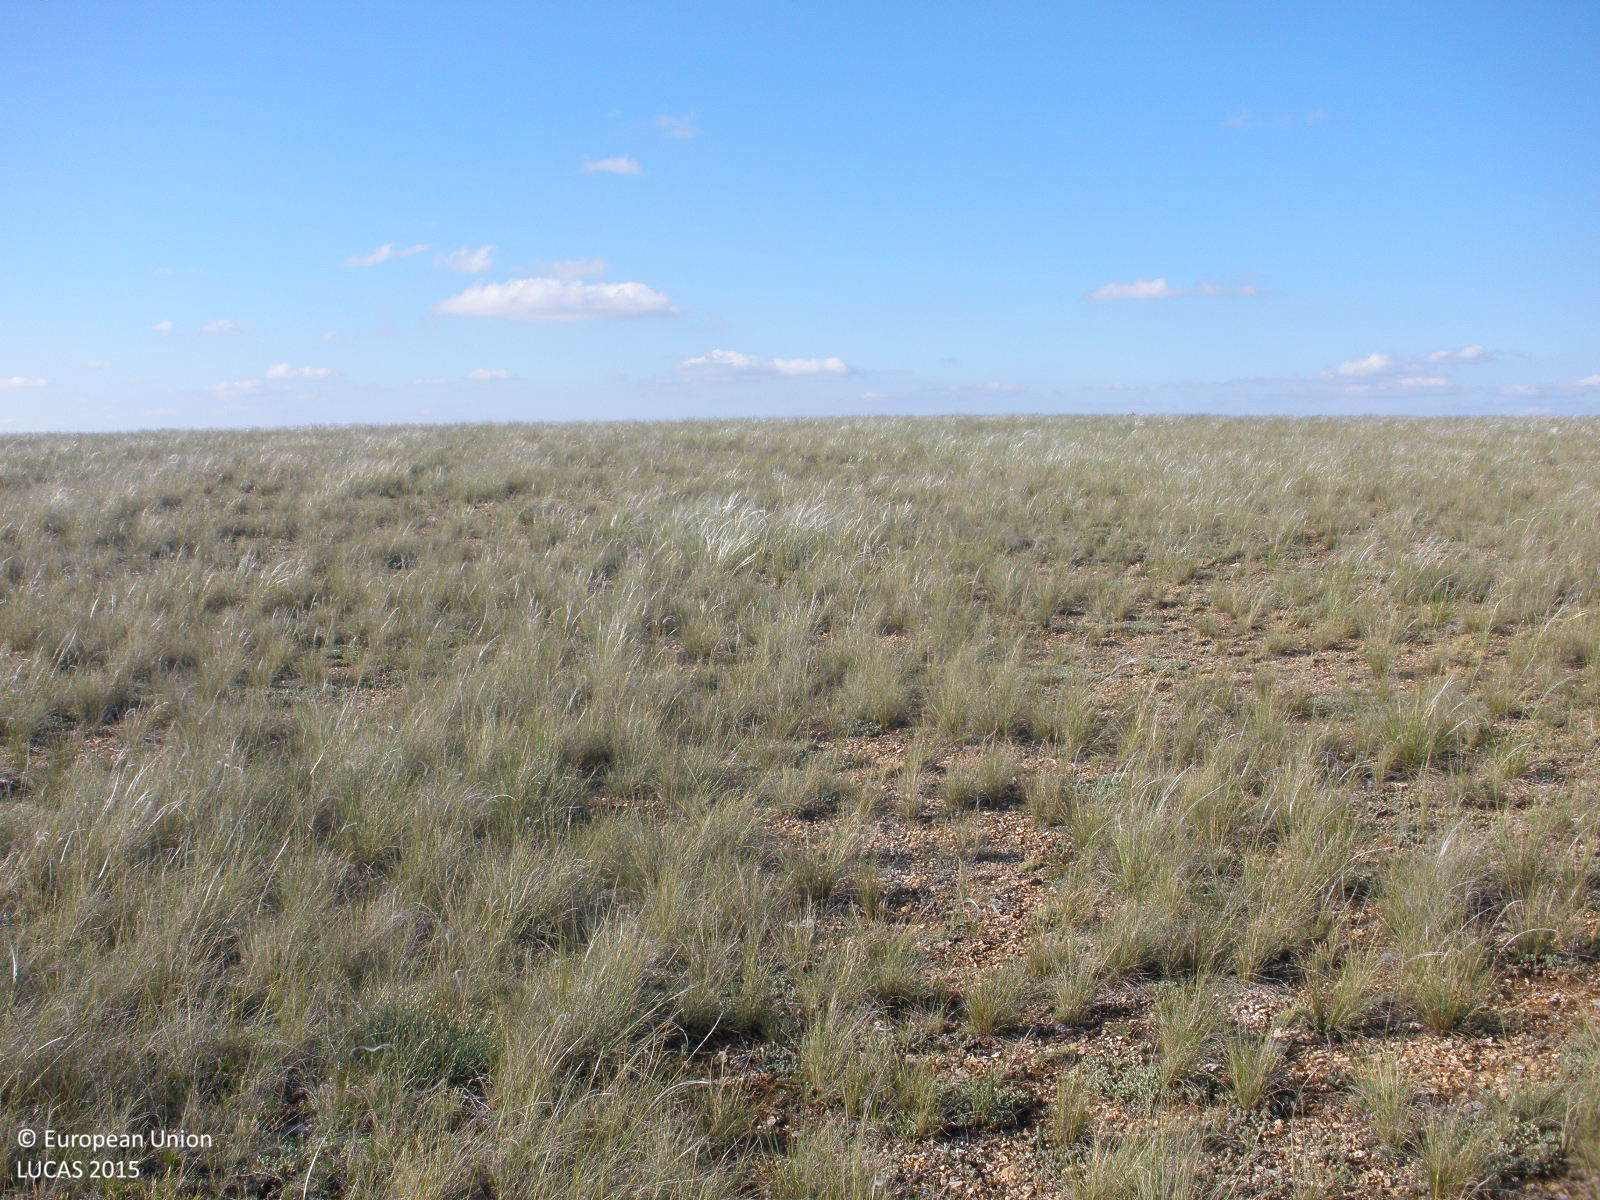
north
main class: Grassland
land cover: Grassland without tree/shrub cover
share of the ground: > 75 %
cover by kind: herbaceous plants 80 %, unconsolidated bare surface 20 %
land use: Semi-natural and natural areas not in use
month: June
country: ES
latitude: 40.5915
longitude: -0.8703
